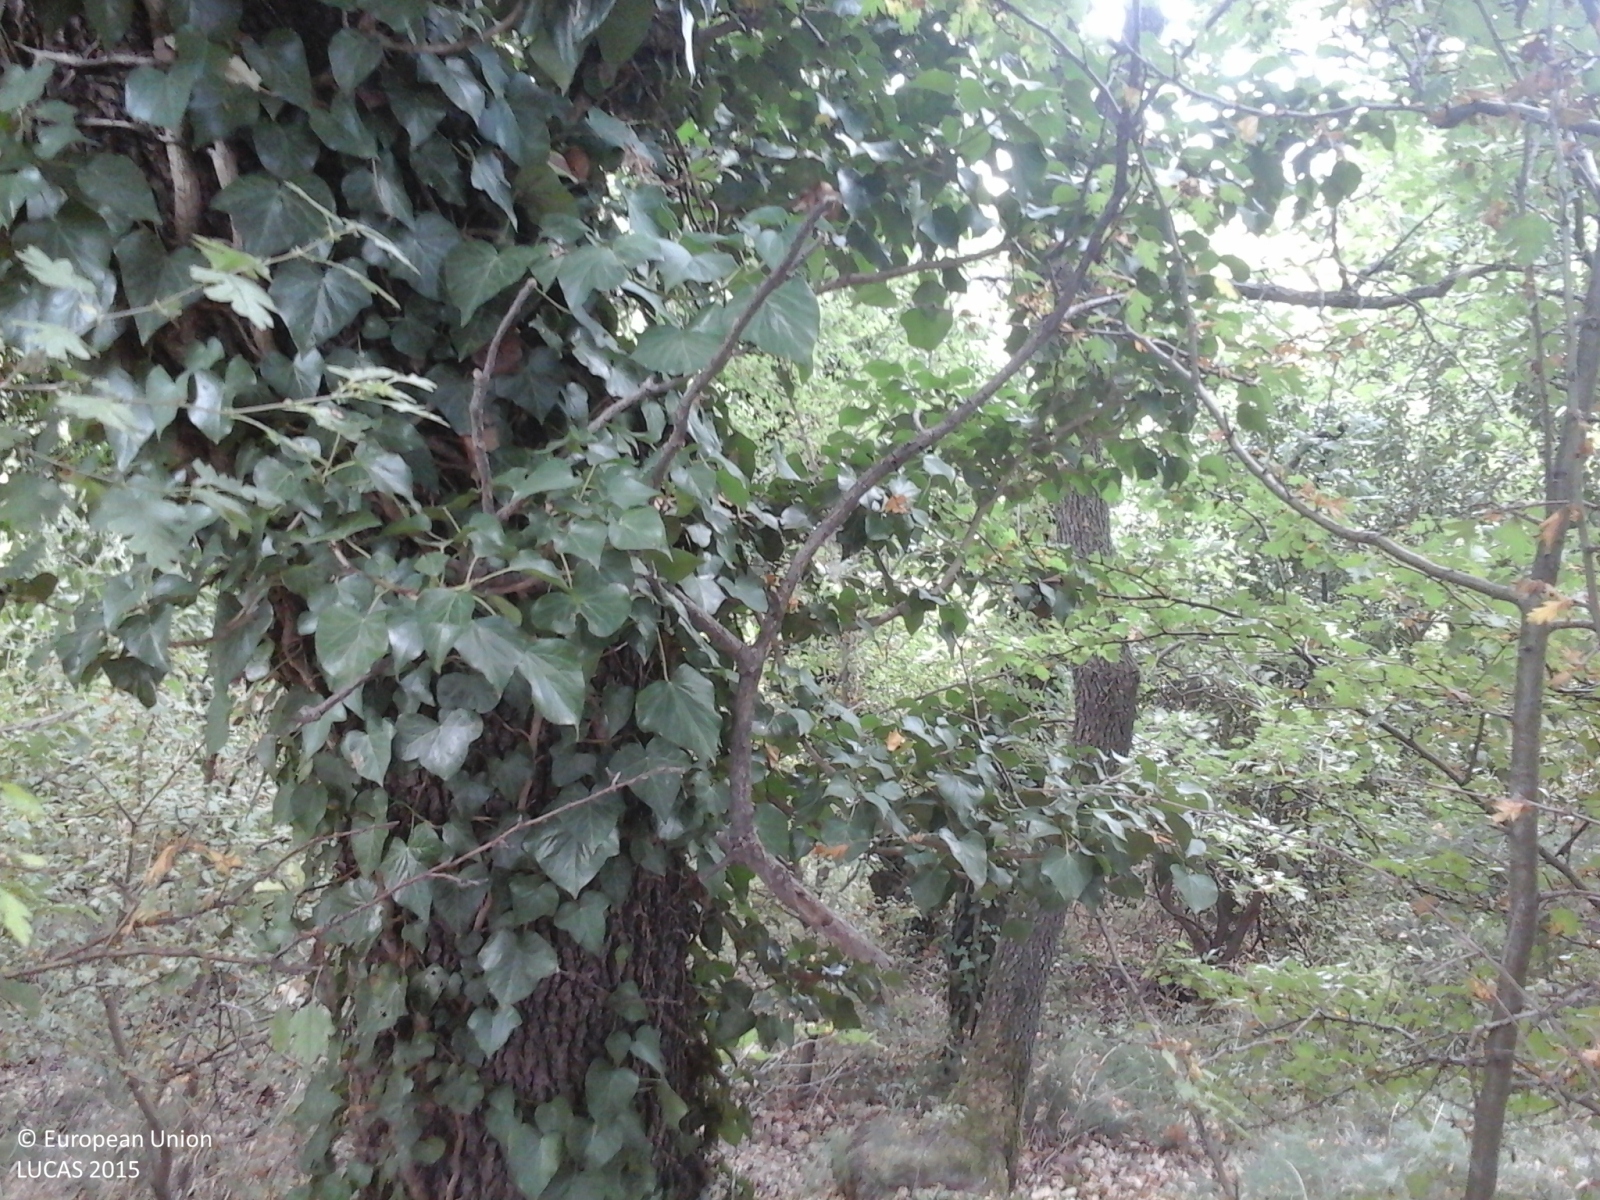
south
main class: Woodland
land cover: Broadleaved woodland
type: thermophilous deciduous forest
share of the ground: > 75 %
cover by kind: broadleaved forest trees 95 %, shrubs 5 %
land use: Forestry
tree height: > 5 m
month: July
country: IT
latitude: 43.3203
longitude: 13.3823
